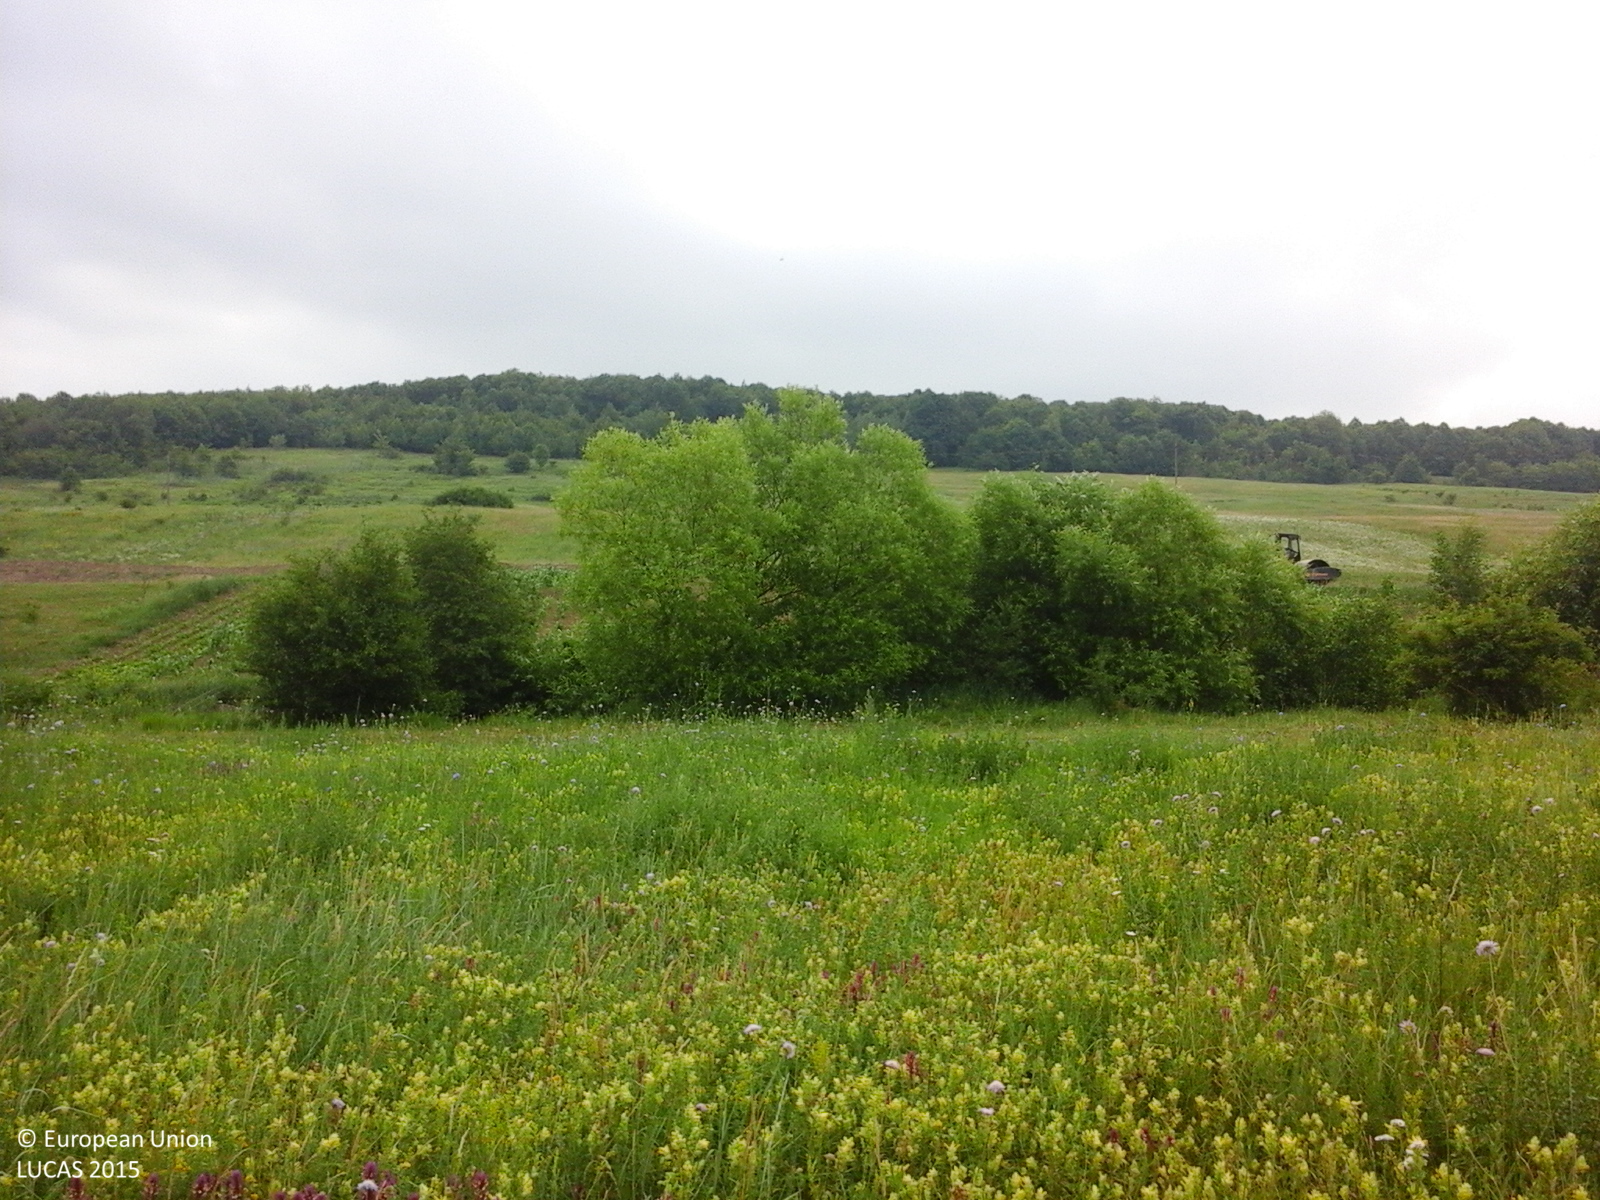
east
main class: Grassland
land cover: Grassland without tree/shrub cover
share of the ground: > 75 %
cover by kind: herbaceous plants 100 %
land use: Agriculture (excluding fallow land and kitchen gardens)
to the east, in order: Grassland without tree/shrub cover; Tracks; Grass margins; Lines of trees; Ditches and canals; Grass margins; Maize; Sugar beet; Grass margins; Paved roads, cycling and walking lanes; Ditches and canals; Other bare soil; Grassland without tree/shrub cover
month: June
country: RO
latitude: 47.5641
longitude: 26.4496
